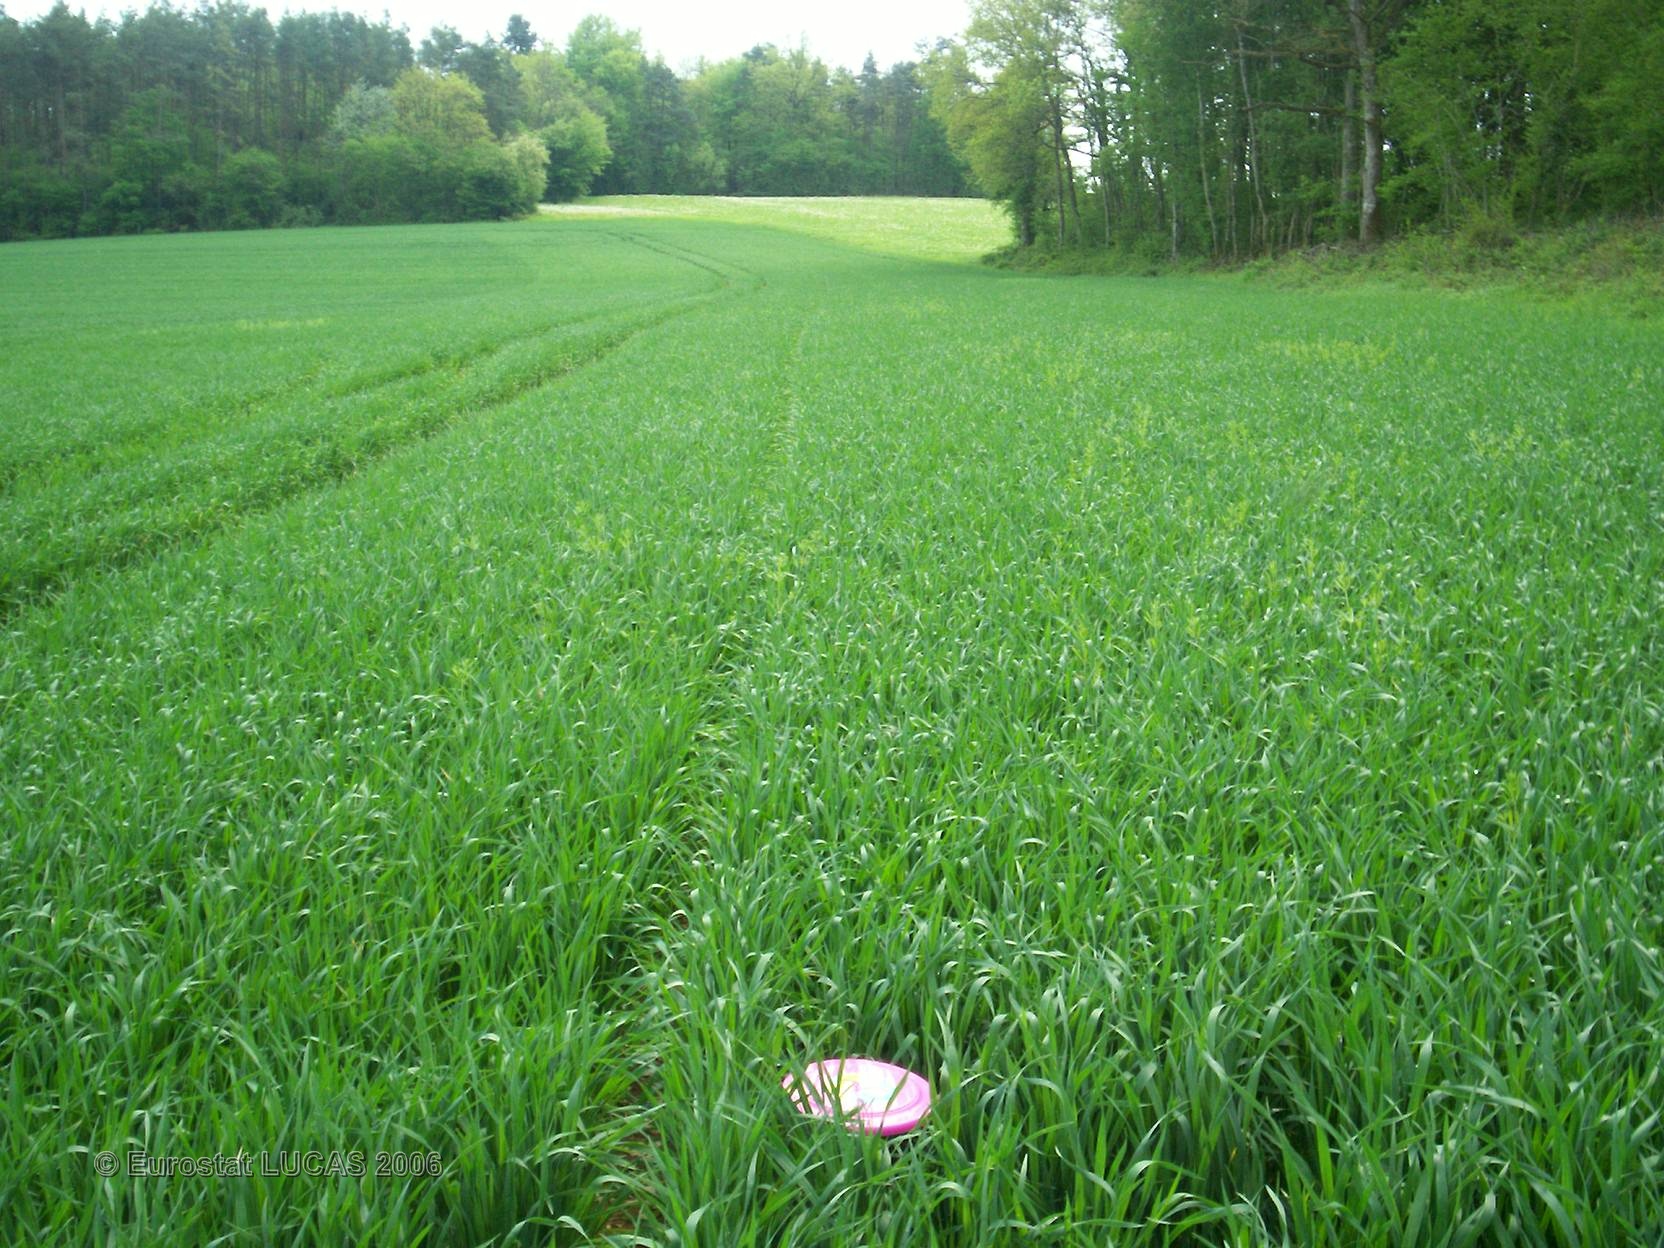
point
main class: Cropland
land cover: Common wheat
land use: Agriculture (excluding fallow land and kitchen gardens)
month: May
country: FR
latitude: 47.7138
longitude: 4.6272
